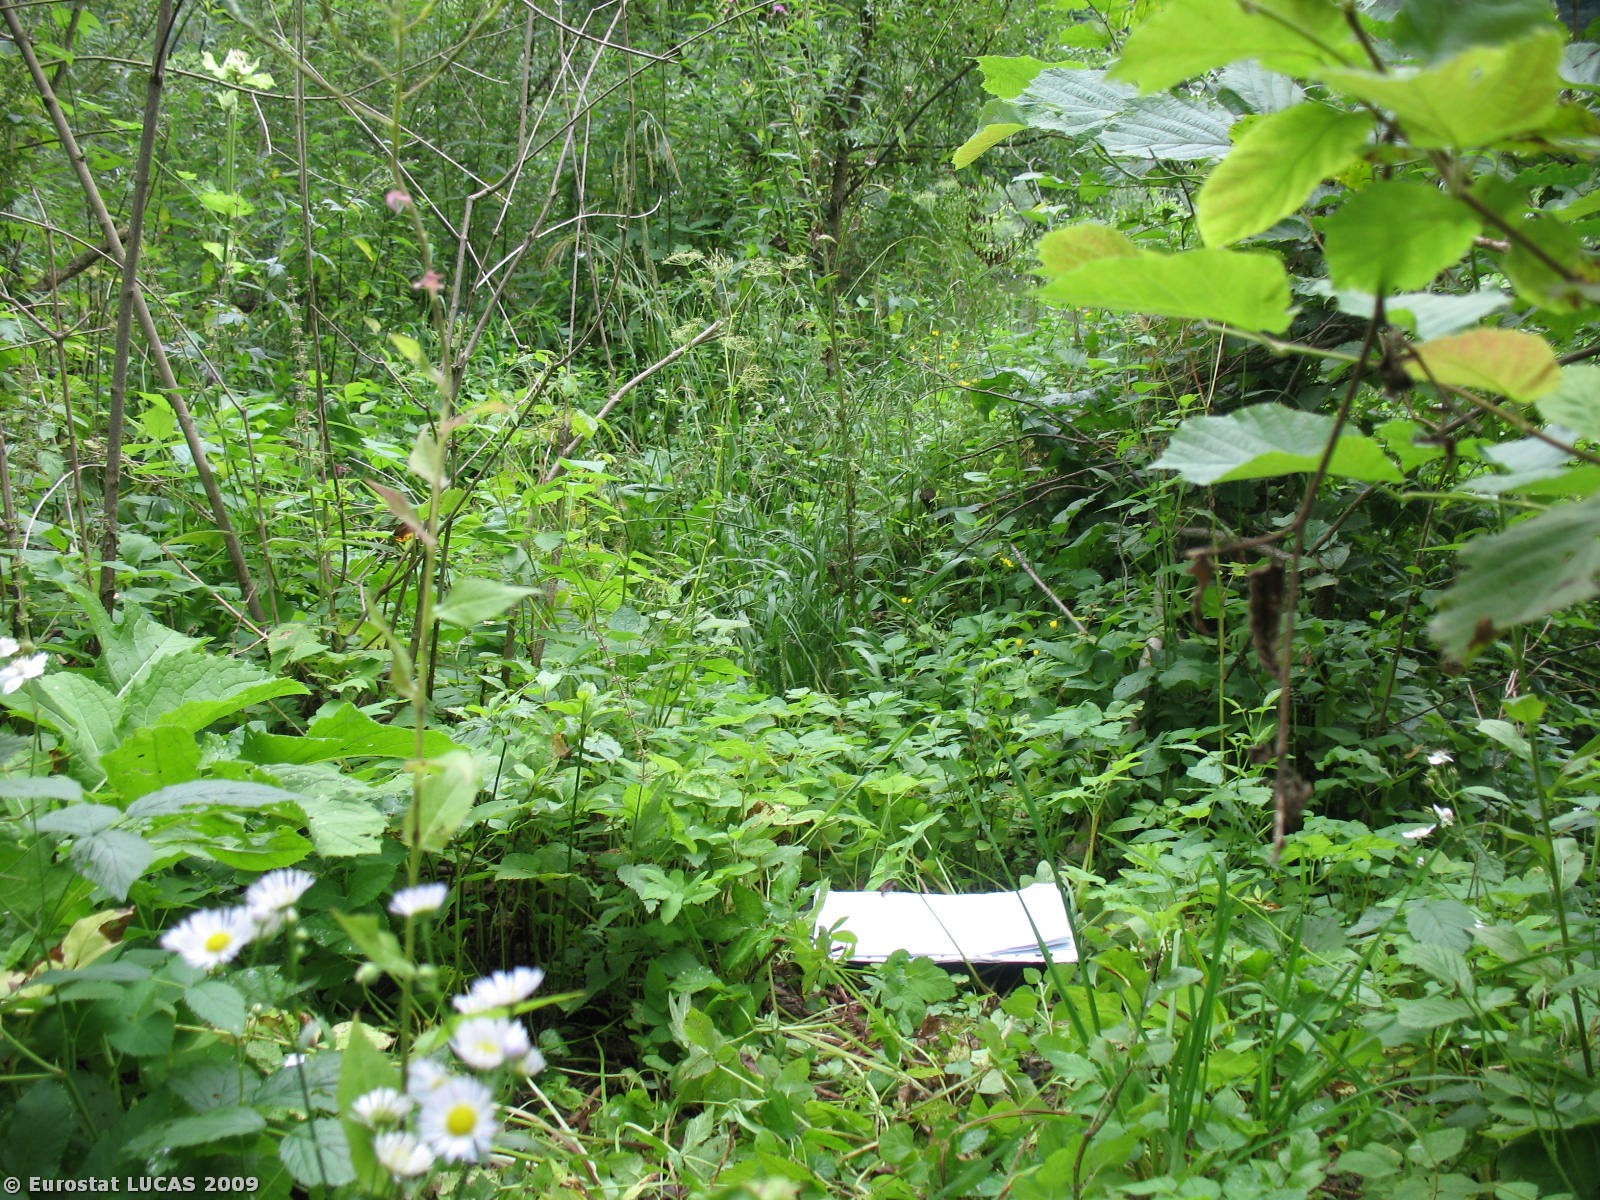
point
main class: Shrubland
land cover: Shrubland with sparse tree cover
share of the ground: > 75 %
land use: Unused
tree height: > 5 m
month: May
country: PL
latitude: 49.4784
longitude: 22.3035
